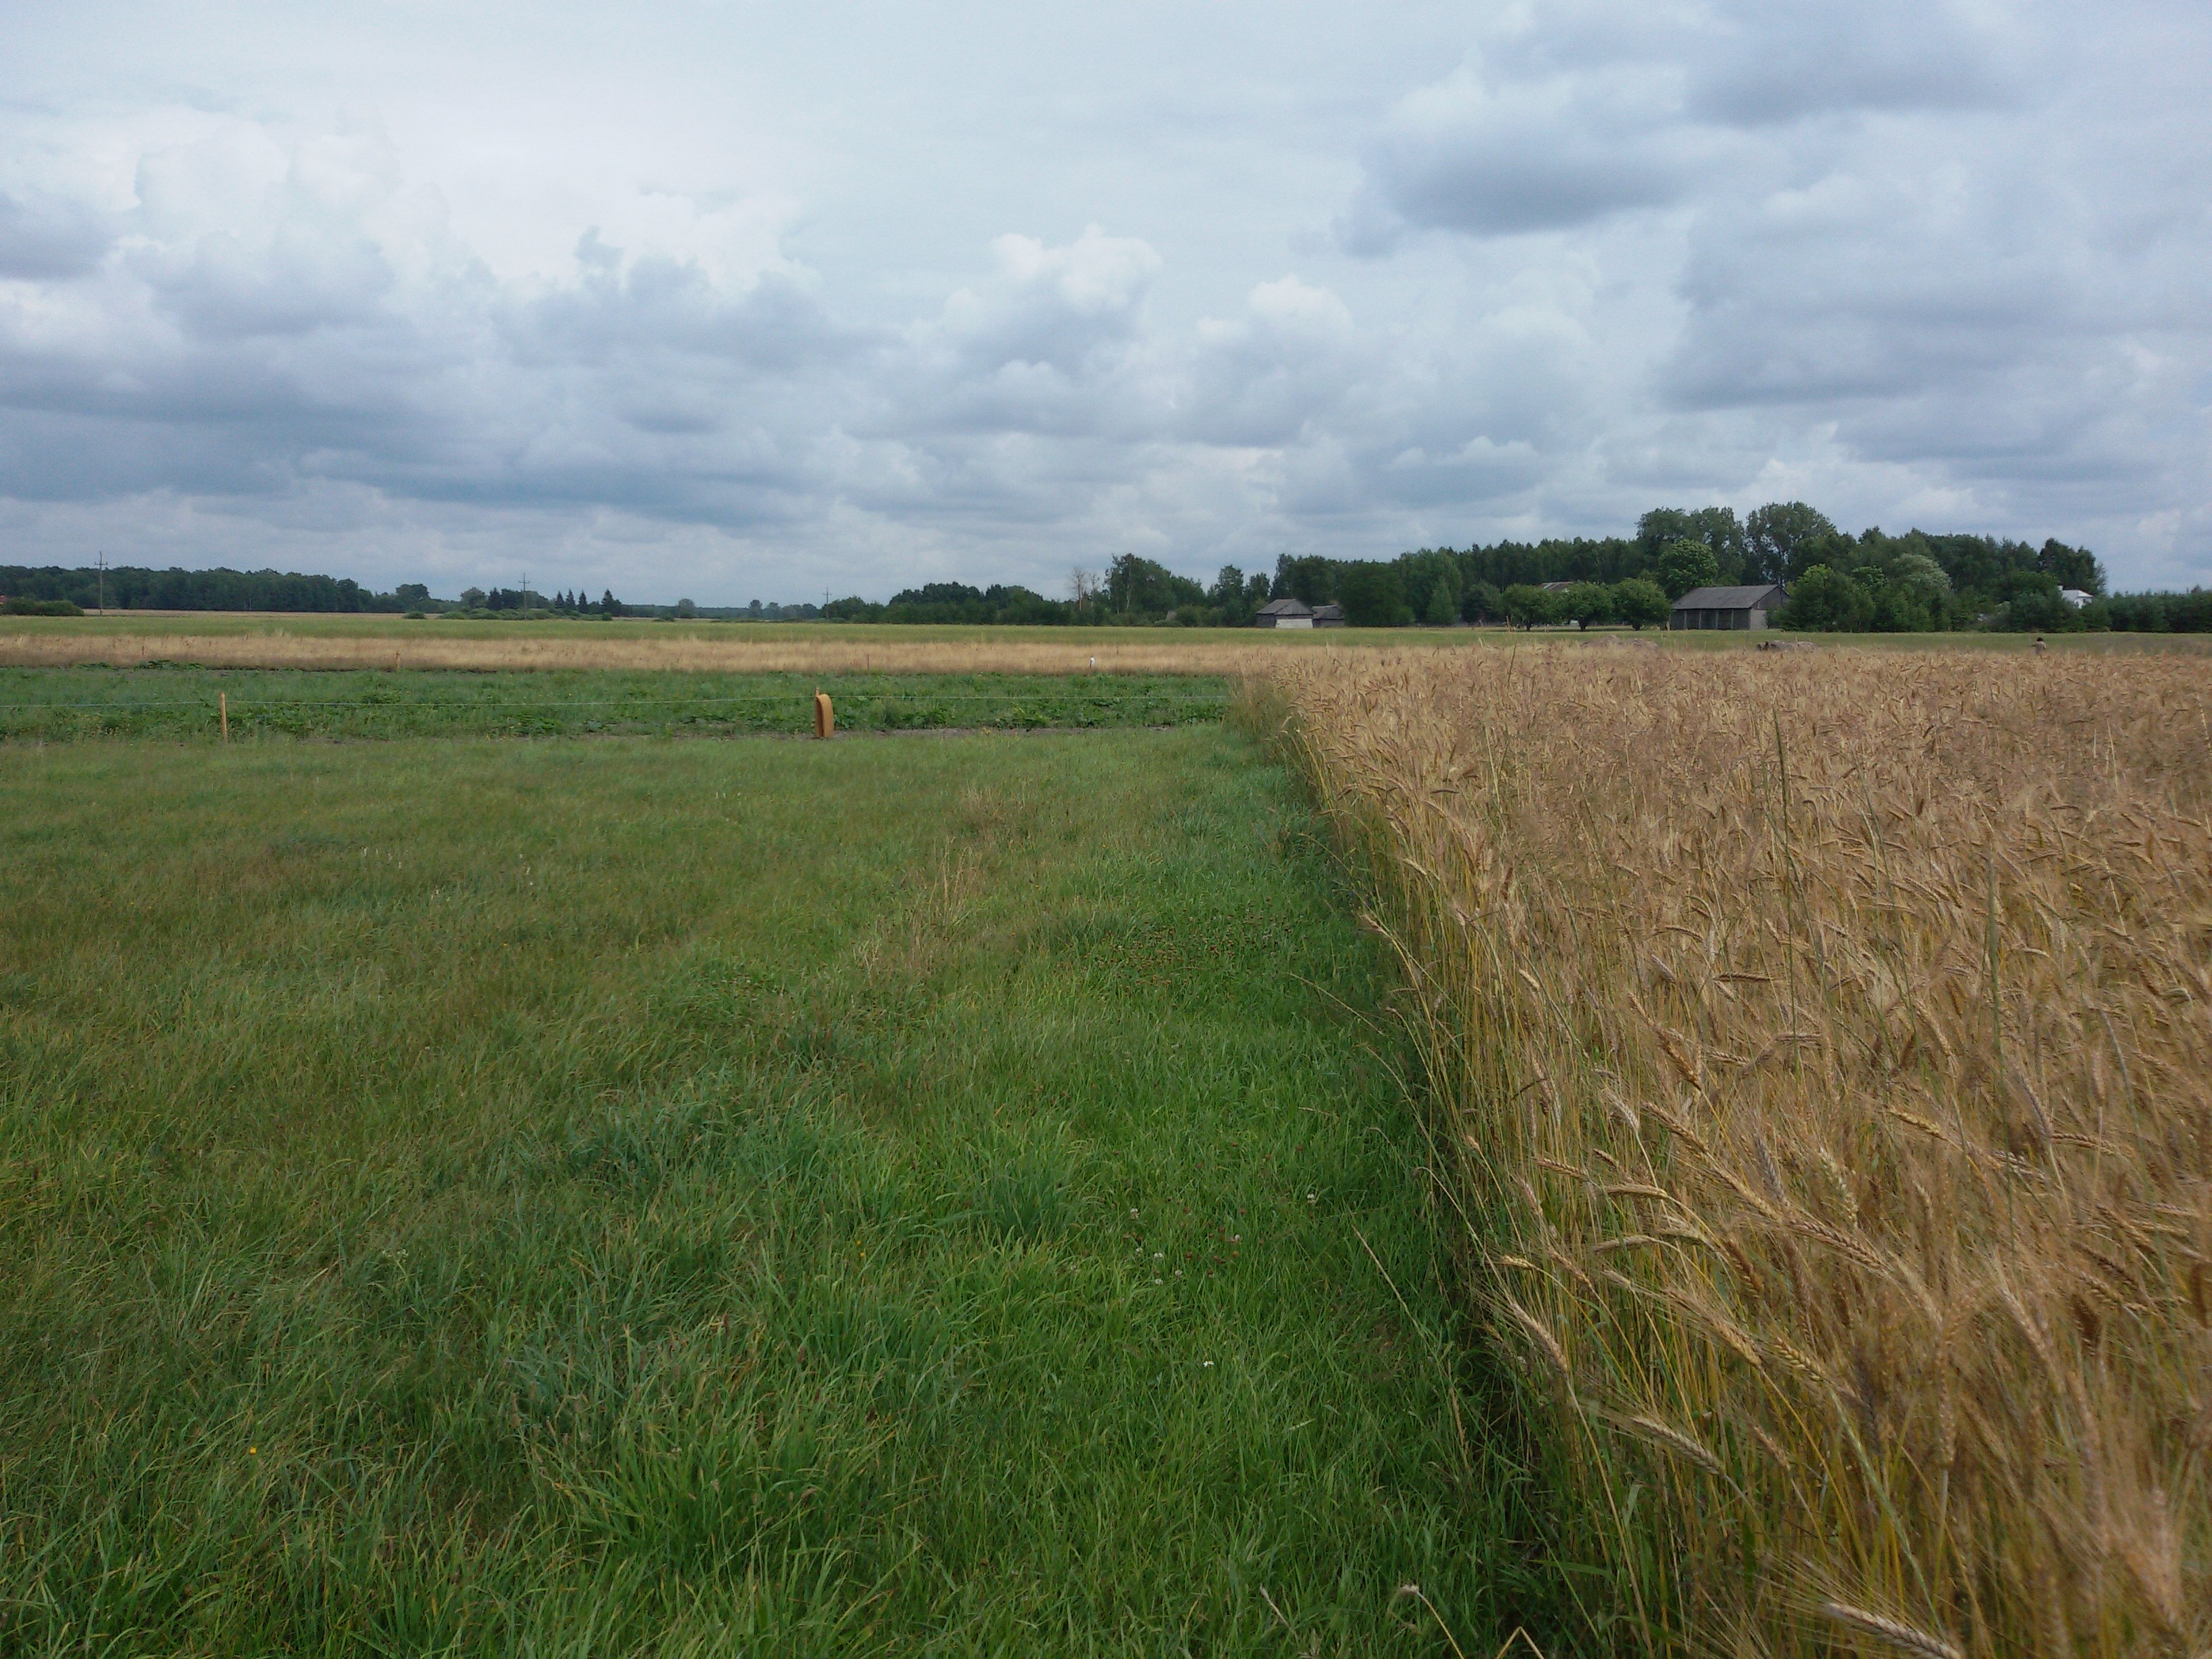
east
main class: Cropland
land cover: Triticale
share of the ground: > 75 %
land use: Agriculture (excluding fallow land and kitchen gardens)
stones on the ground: < 10 %
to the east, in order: Triticale; Fences; Other fresh vegetables; Fences; Grassland without tree/shrub cover; Oats
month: July
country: PL
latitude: 51.8881
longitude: 22.9030
